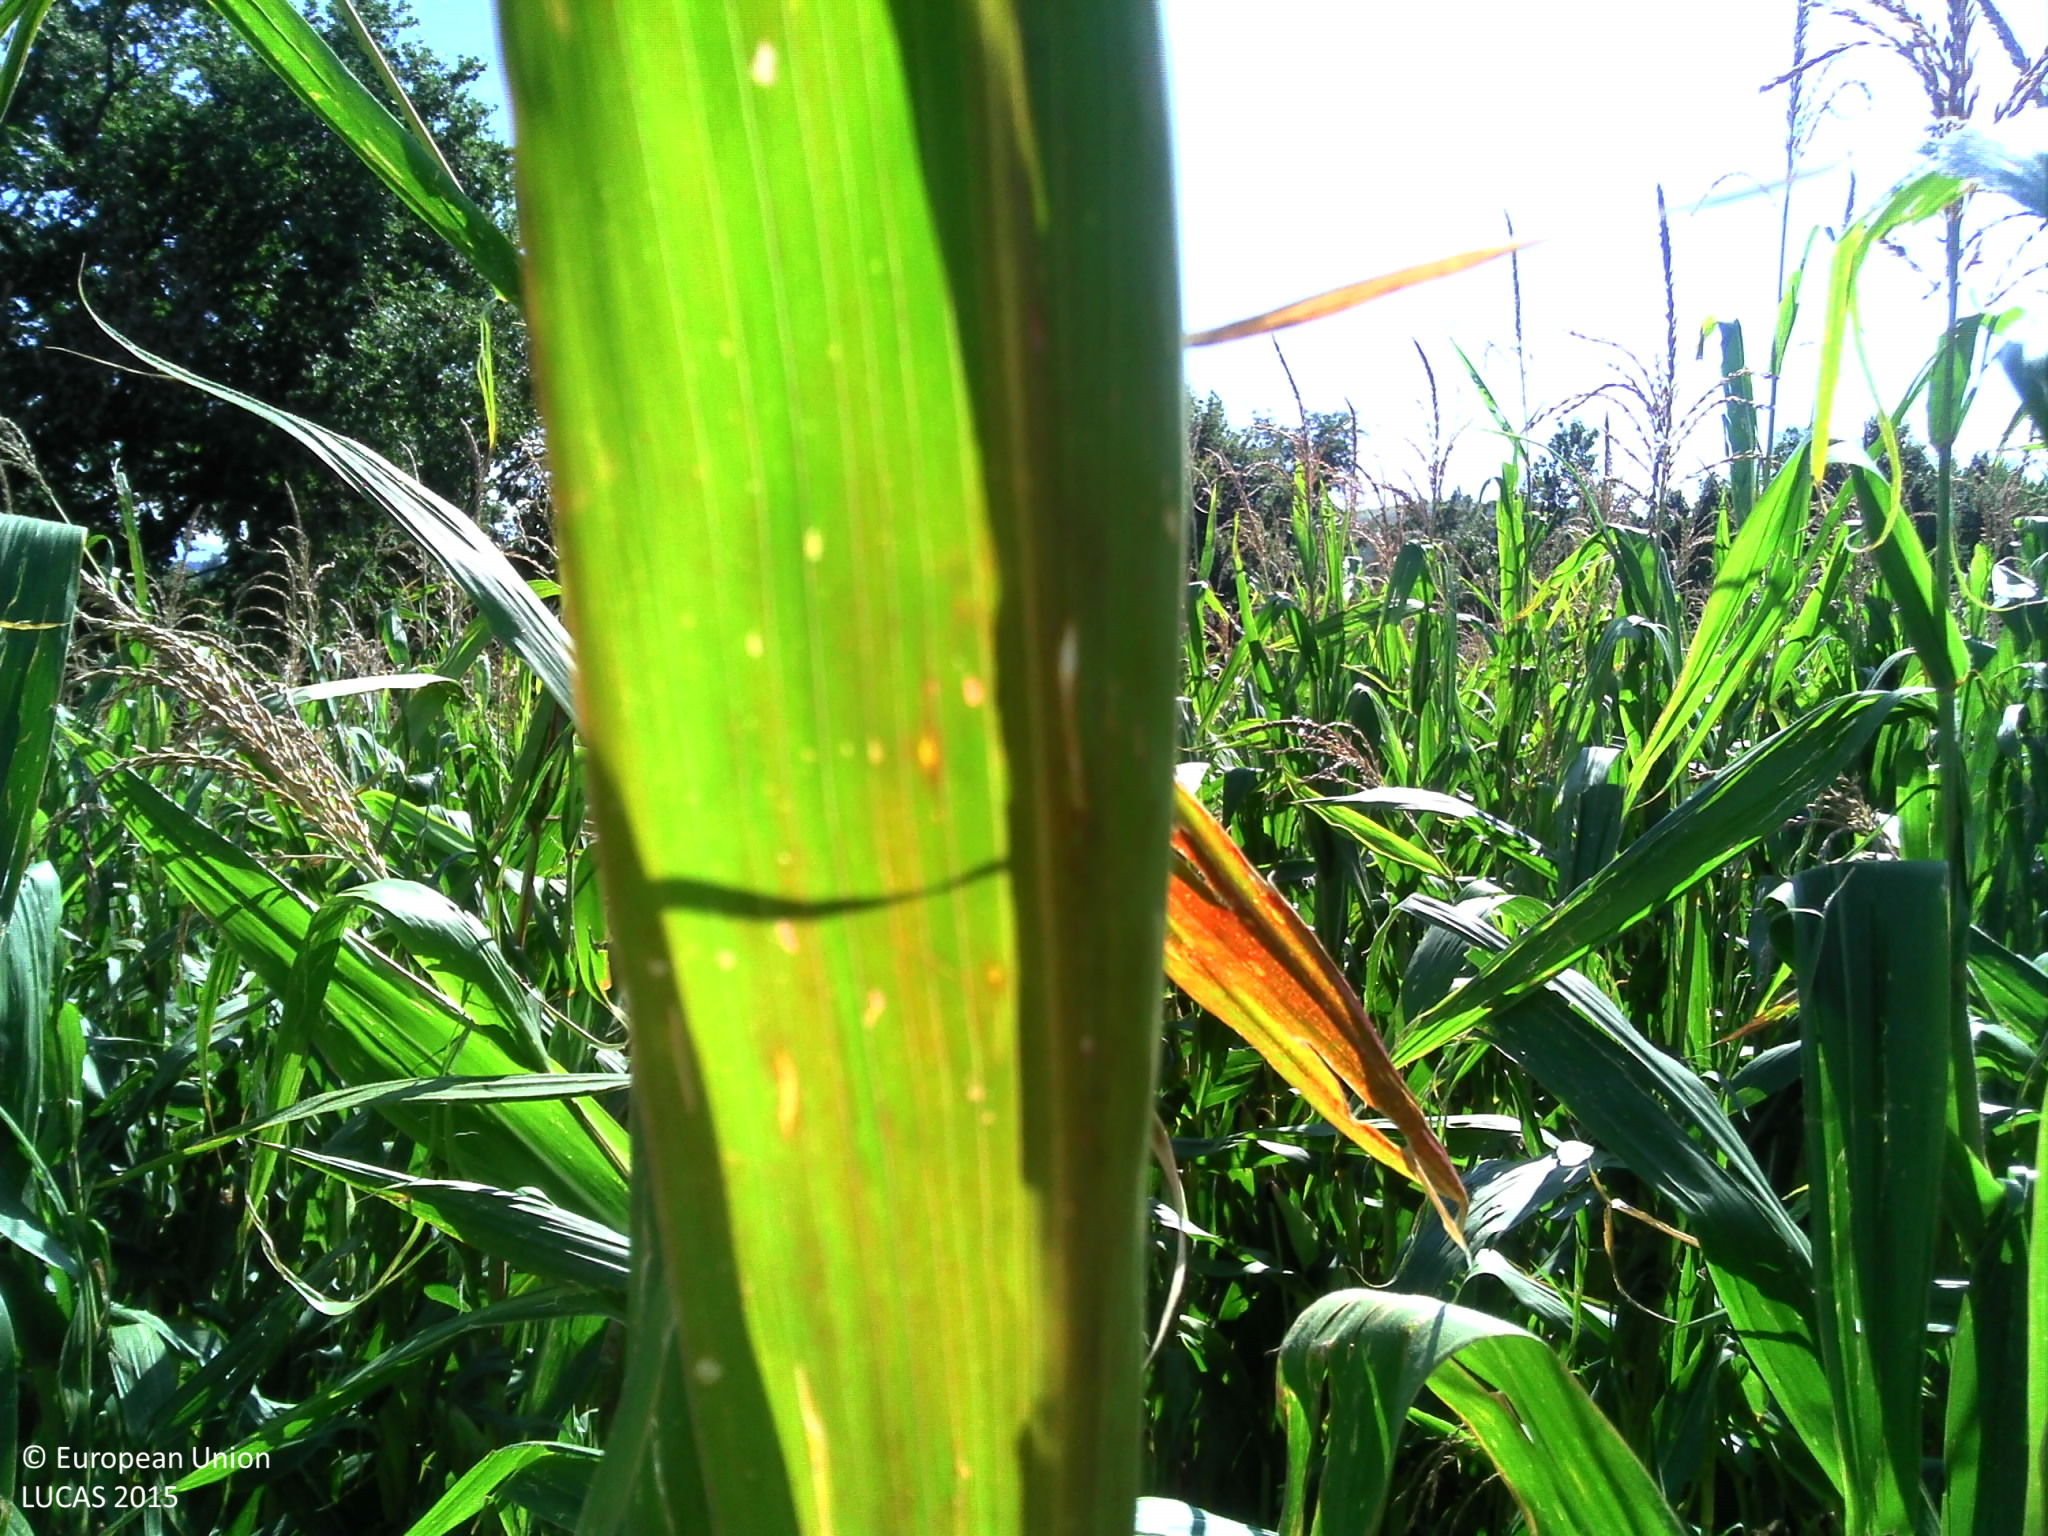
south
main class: Cropland
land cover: Maize
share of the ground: > 75 %
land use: Agriculture (excluding fallow land and kitchen gardens)
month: September
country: FR
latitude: 43.2638
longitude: -0.9139
